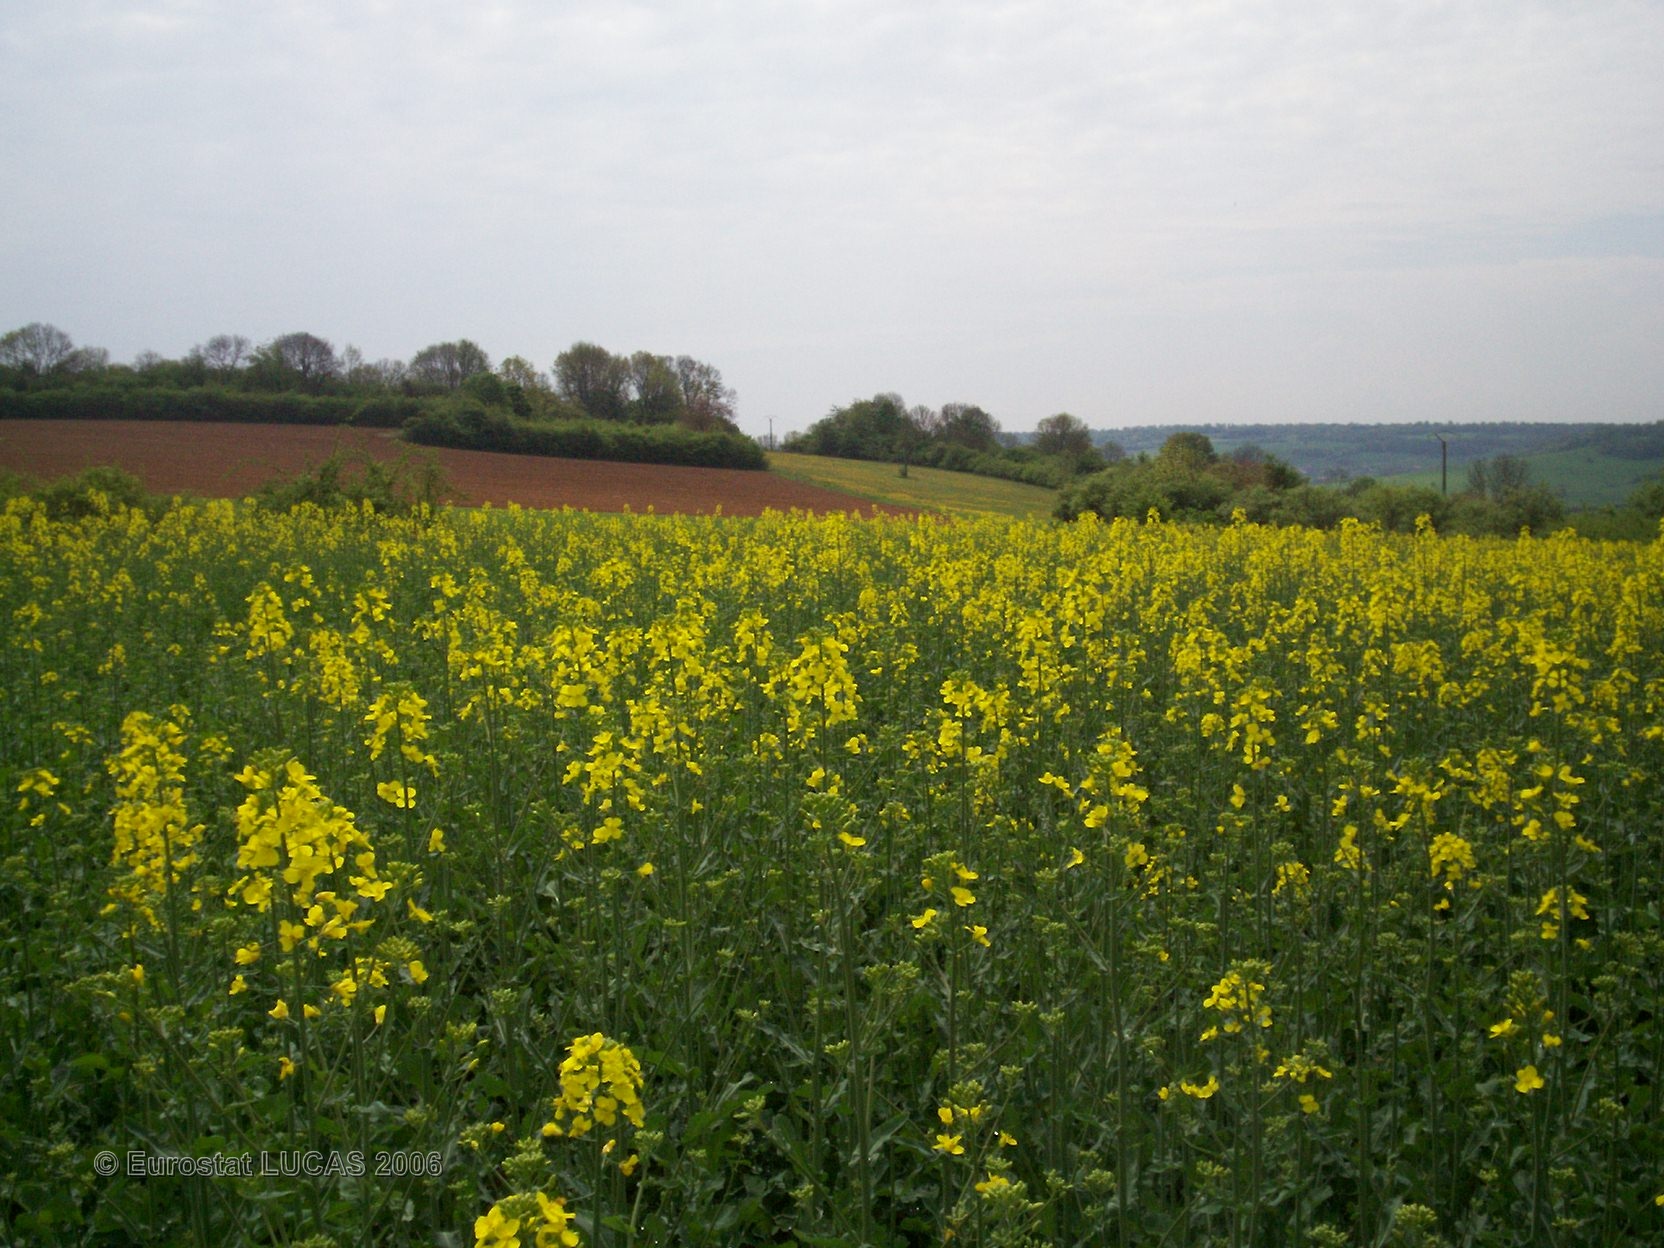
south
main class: Cropland
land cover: Rape and turnip rape
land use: Agriculture (excluding fallow land and kitchen gardens)
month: May
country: FR
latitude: 48.5285
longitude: 5.9782
